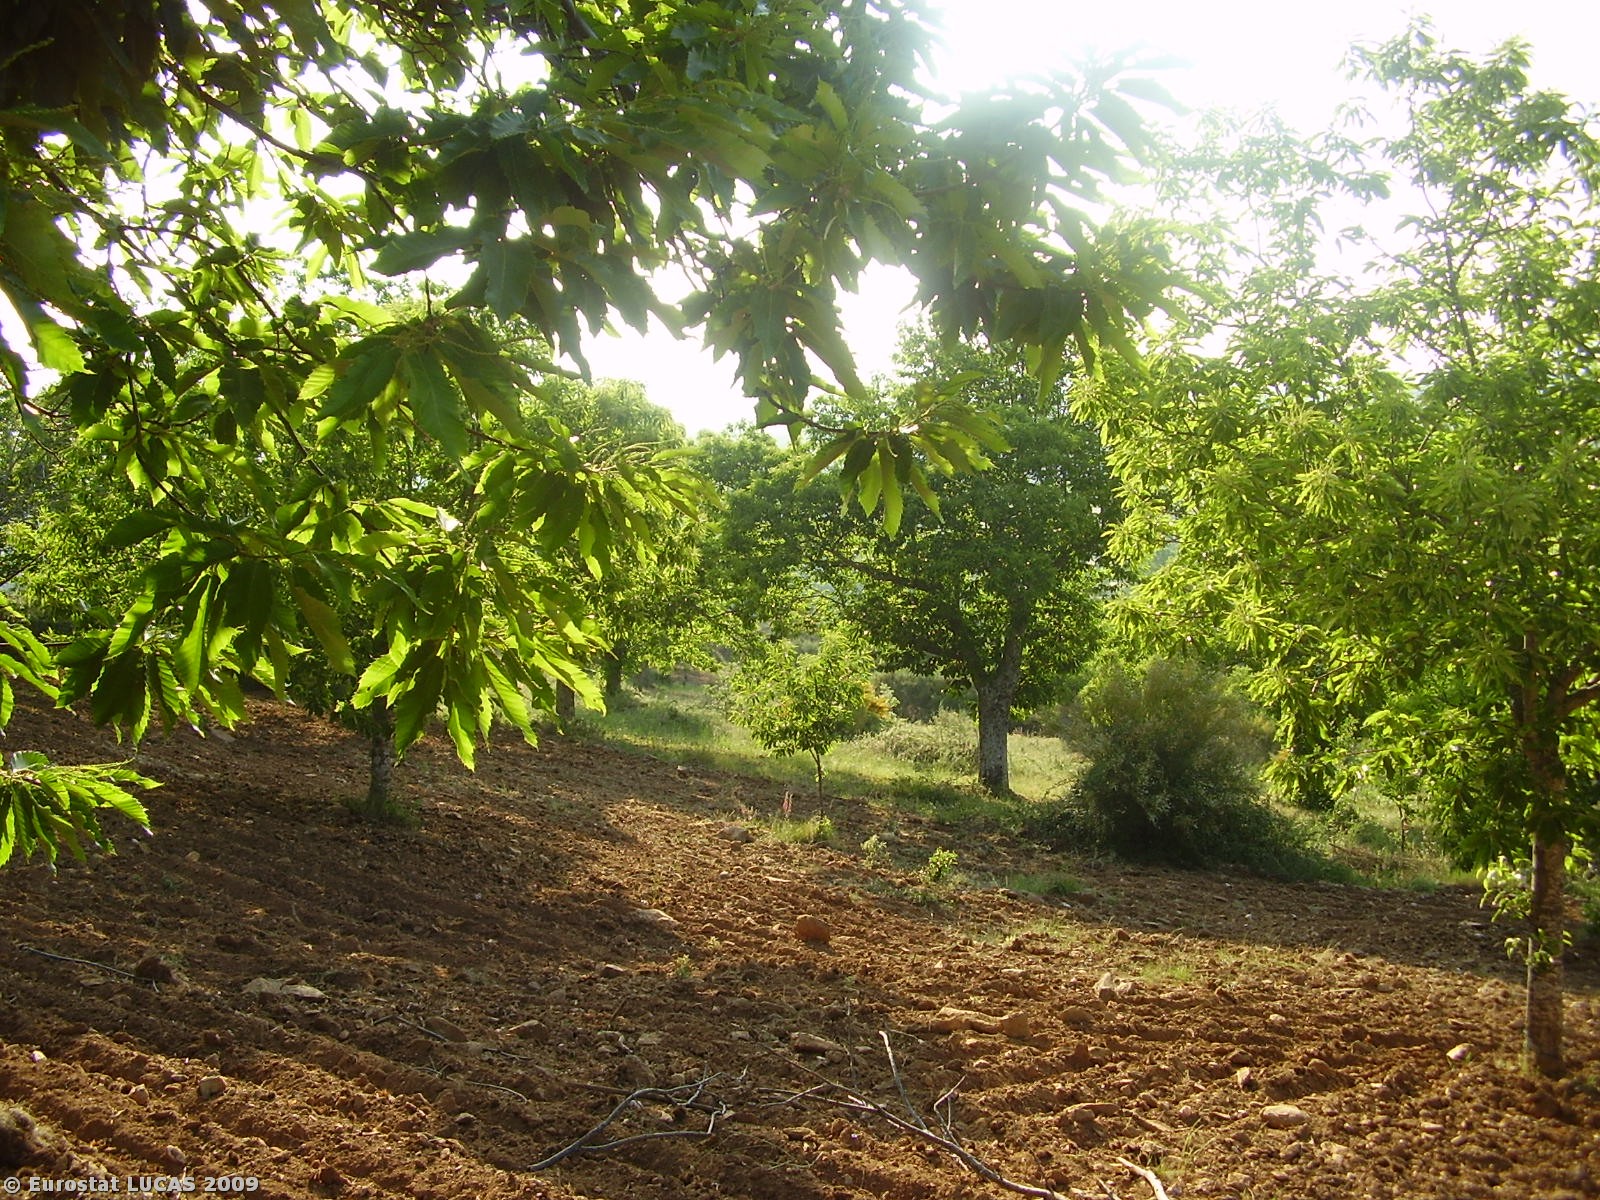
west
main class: Cropland
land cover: Nuts trees
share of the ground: 10 - 25 %
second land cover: Bare land
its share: < 10 %
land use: Agriculture (excluding fallow land and kitchen gardens)
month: June
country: PT
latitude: 41.6243
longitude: -6.8071
